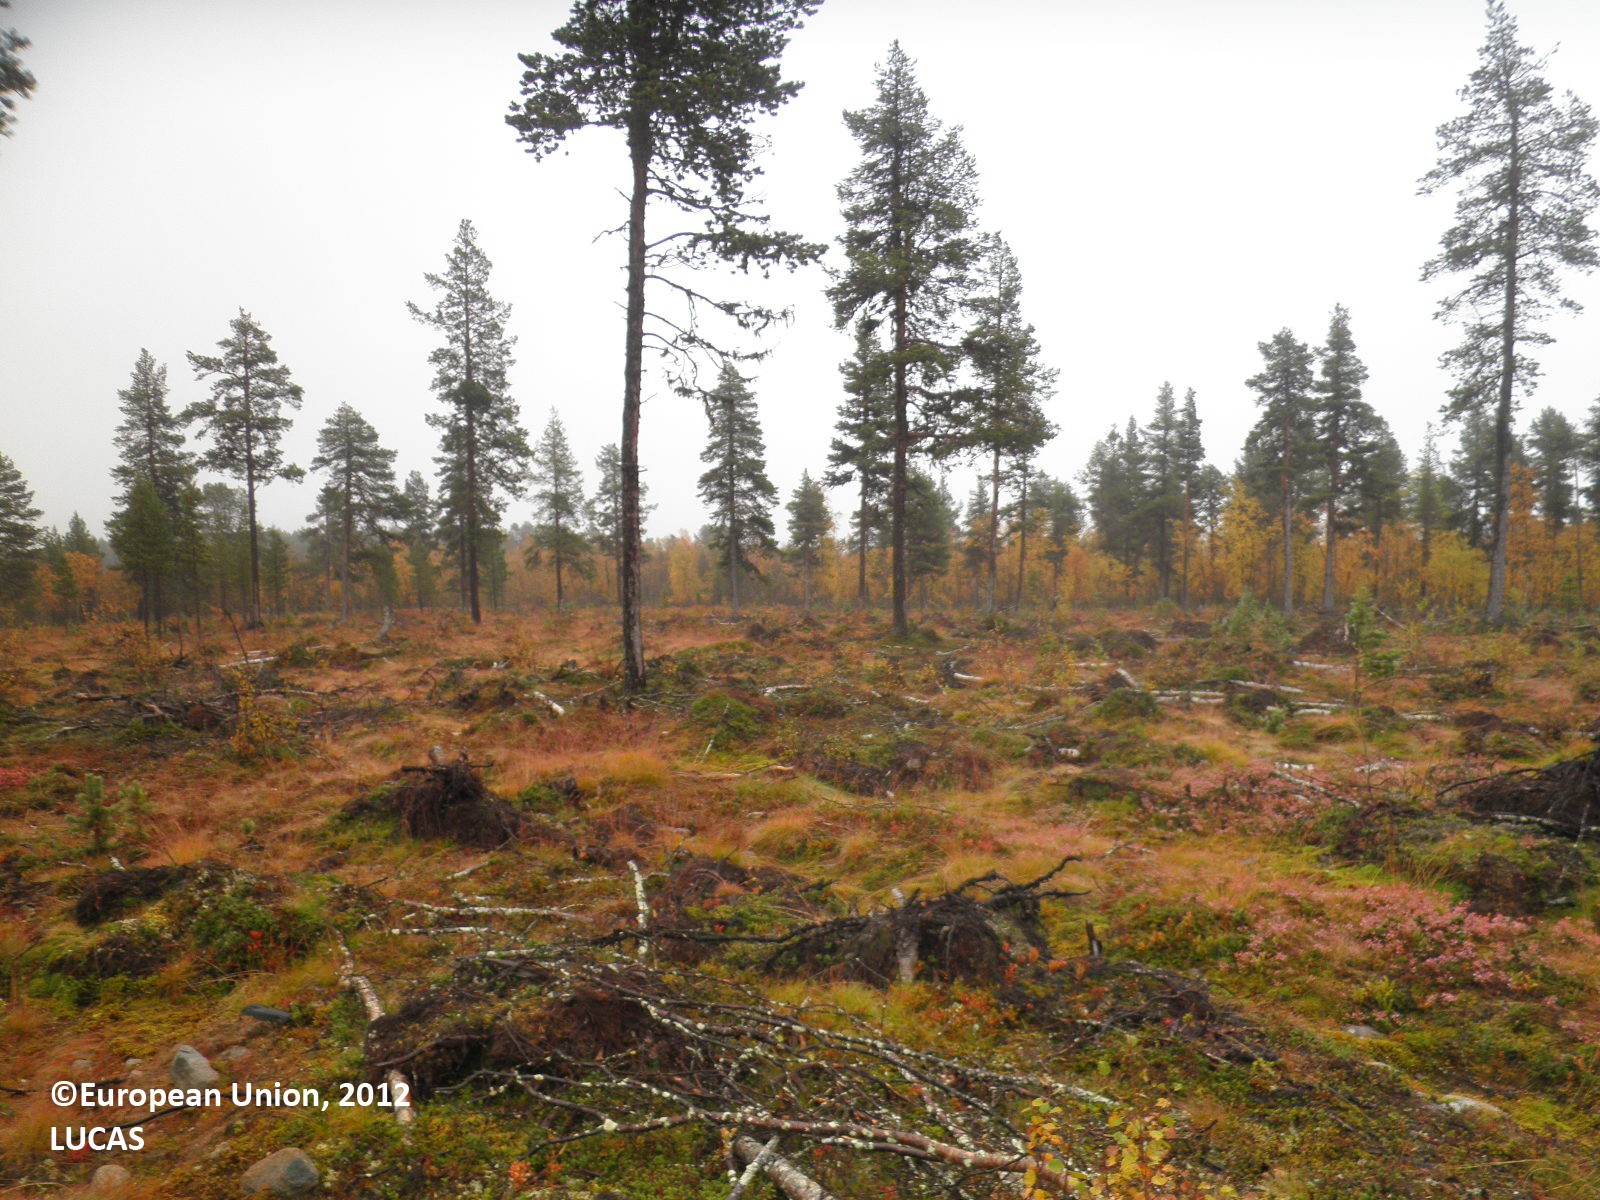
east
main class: Woodland
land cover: Pine dominated coniferous woodland
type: boreal forest
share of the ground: 10 - 25 %
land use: Forestry
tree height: > 5 m
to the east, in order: Pine dominated coniferous woodland; Tracks; Pine dominated mixed woodland
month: September
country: FI
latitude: 68.4387
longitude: 22.7965
